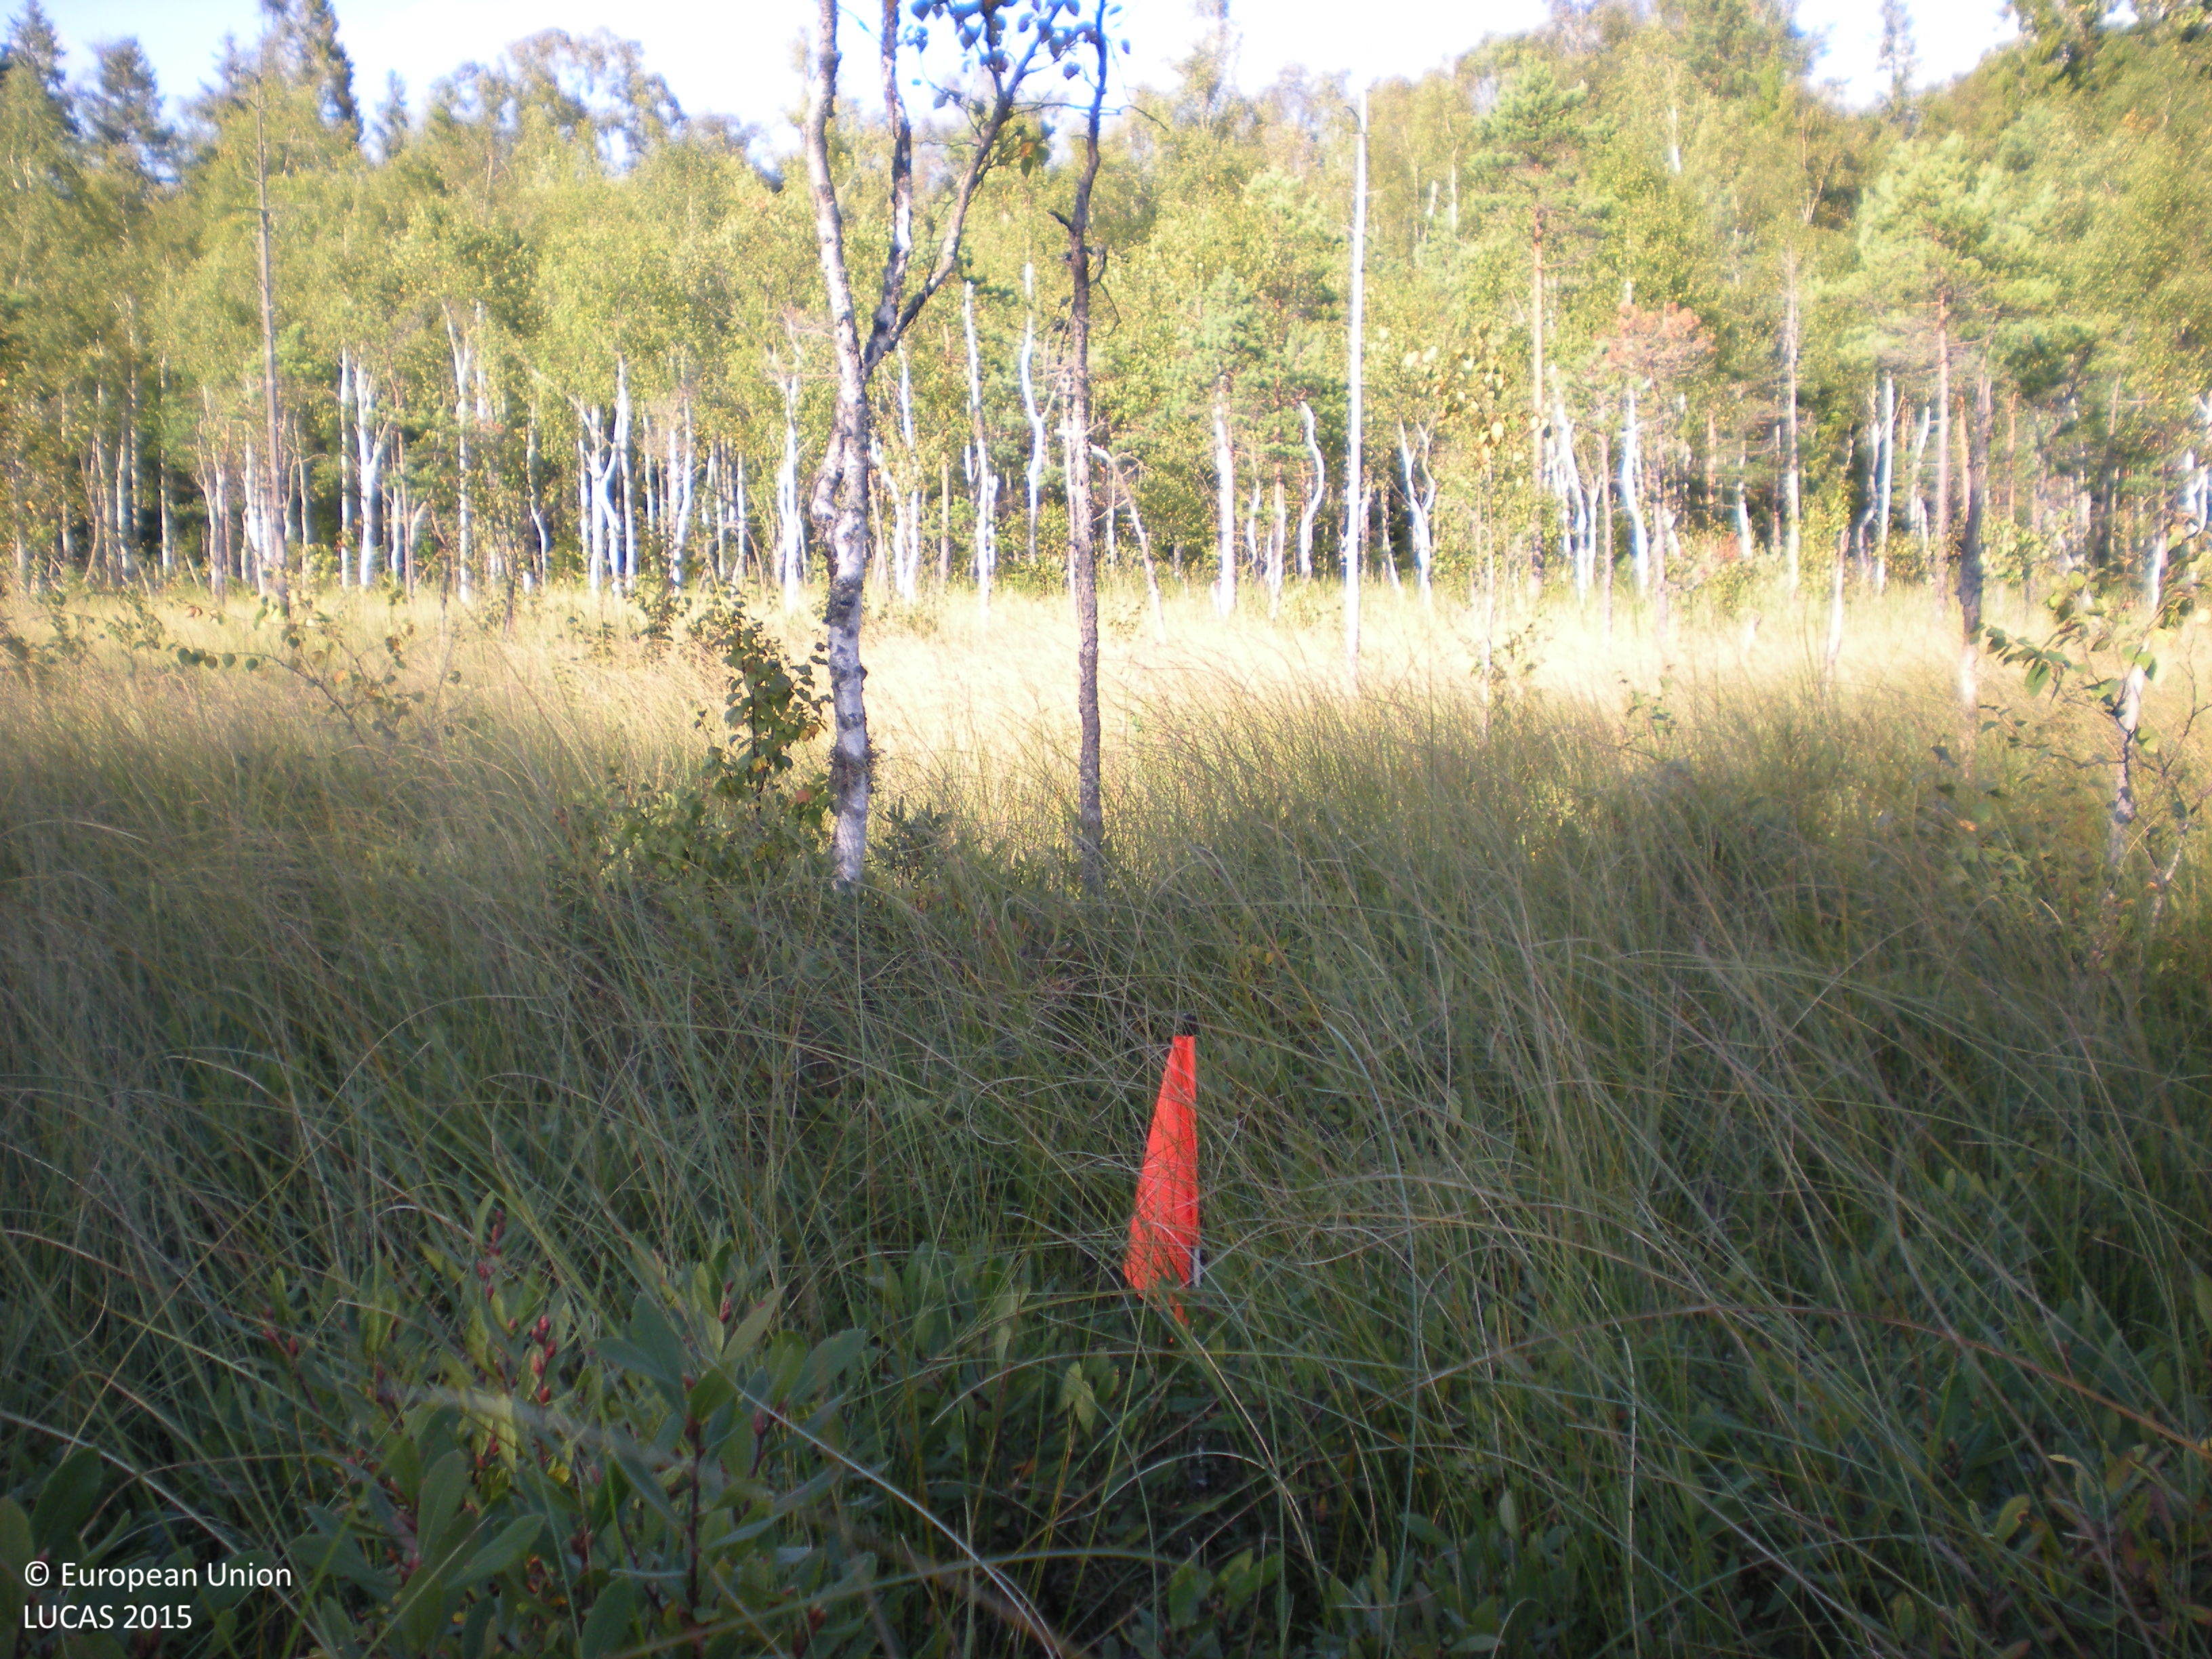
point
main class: Woodland
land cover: Broadleaved woodland
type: mire and swamp forests
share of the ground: > 75 %
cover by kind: herbaceous plants 70 %, broadleaved forest trees 15 %, shrubs 15 %
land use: Semi-natural and natural areas not in use
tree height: < 5 m
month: August
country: SE
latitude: 60.5453
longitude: 17.0813
